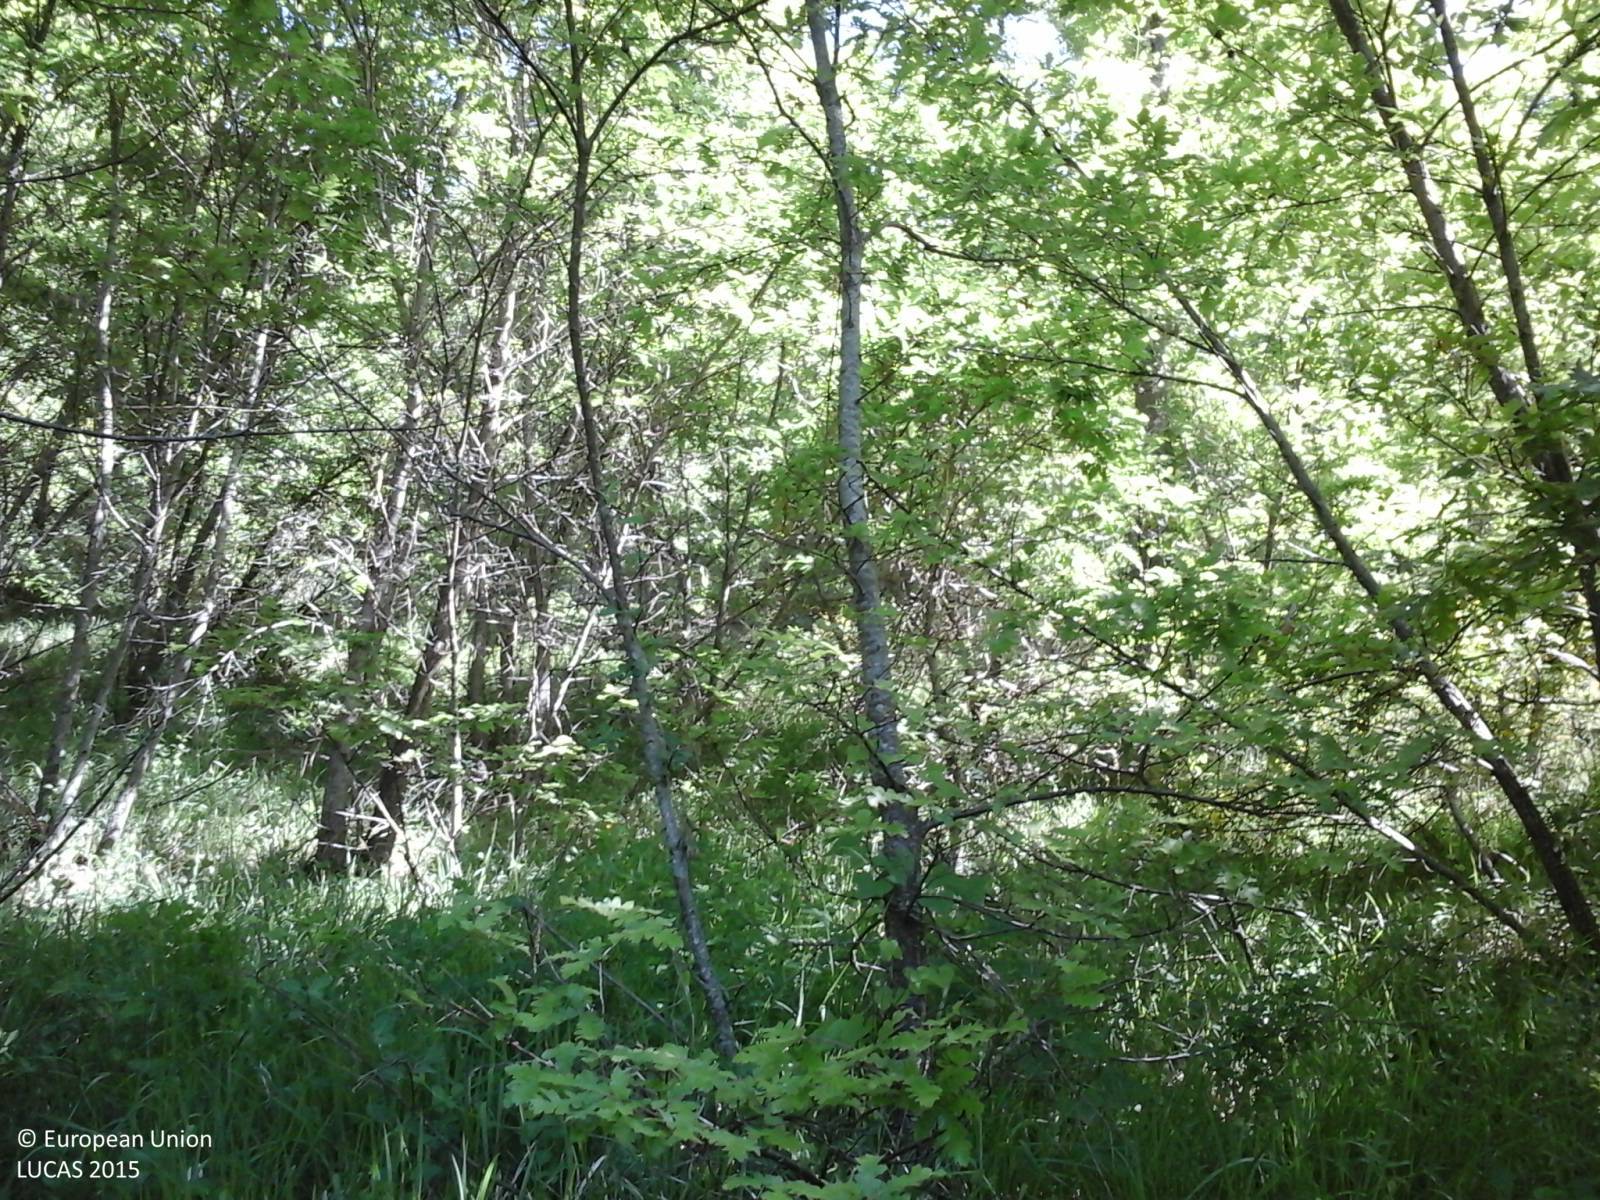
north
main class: Woodland
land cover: Broadleaved woodland
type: thermophilous deciduous forest
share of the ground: > 75 %
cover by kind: broadleaved forest trees 90 %, shrubs 5 %, herbaceous plants 5 %
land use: Forestry
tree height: > 5 m
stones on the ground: < 10 %
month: May
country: IT
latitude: 42.1148
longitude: 13.2182
